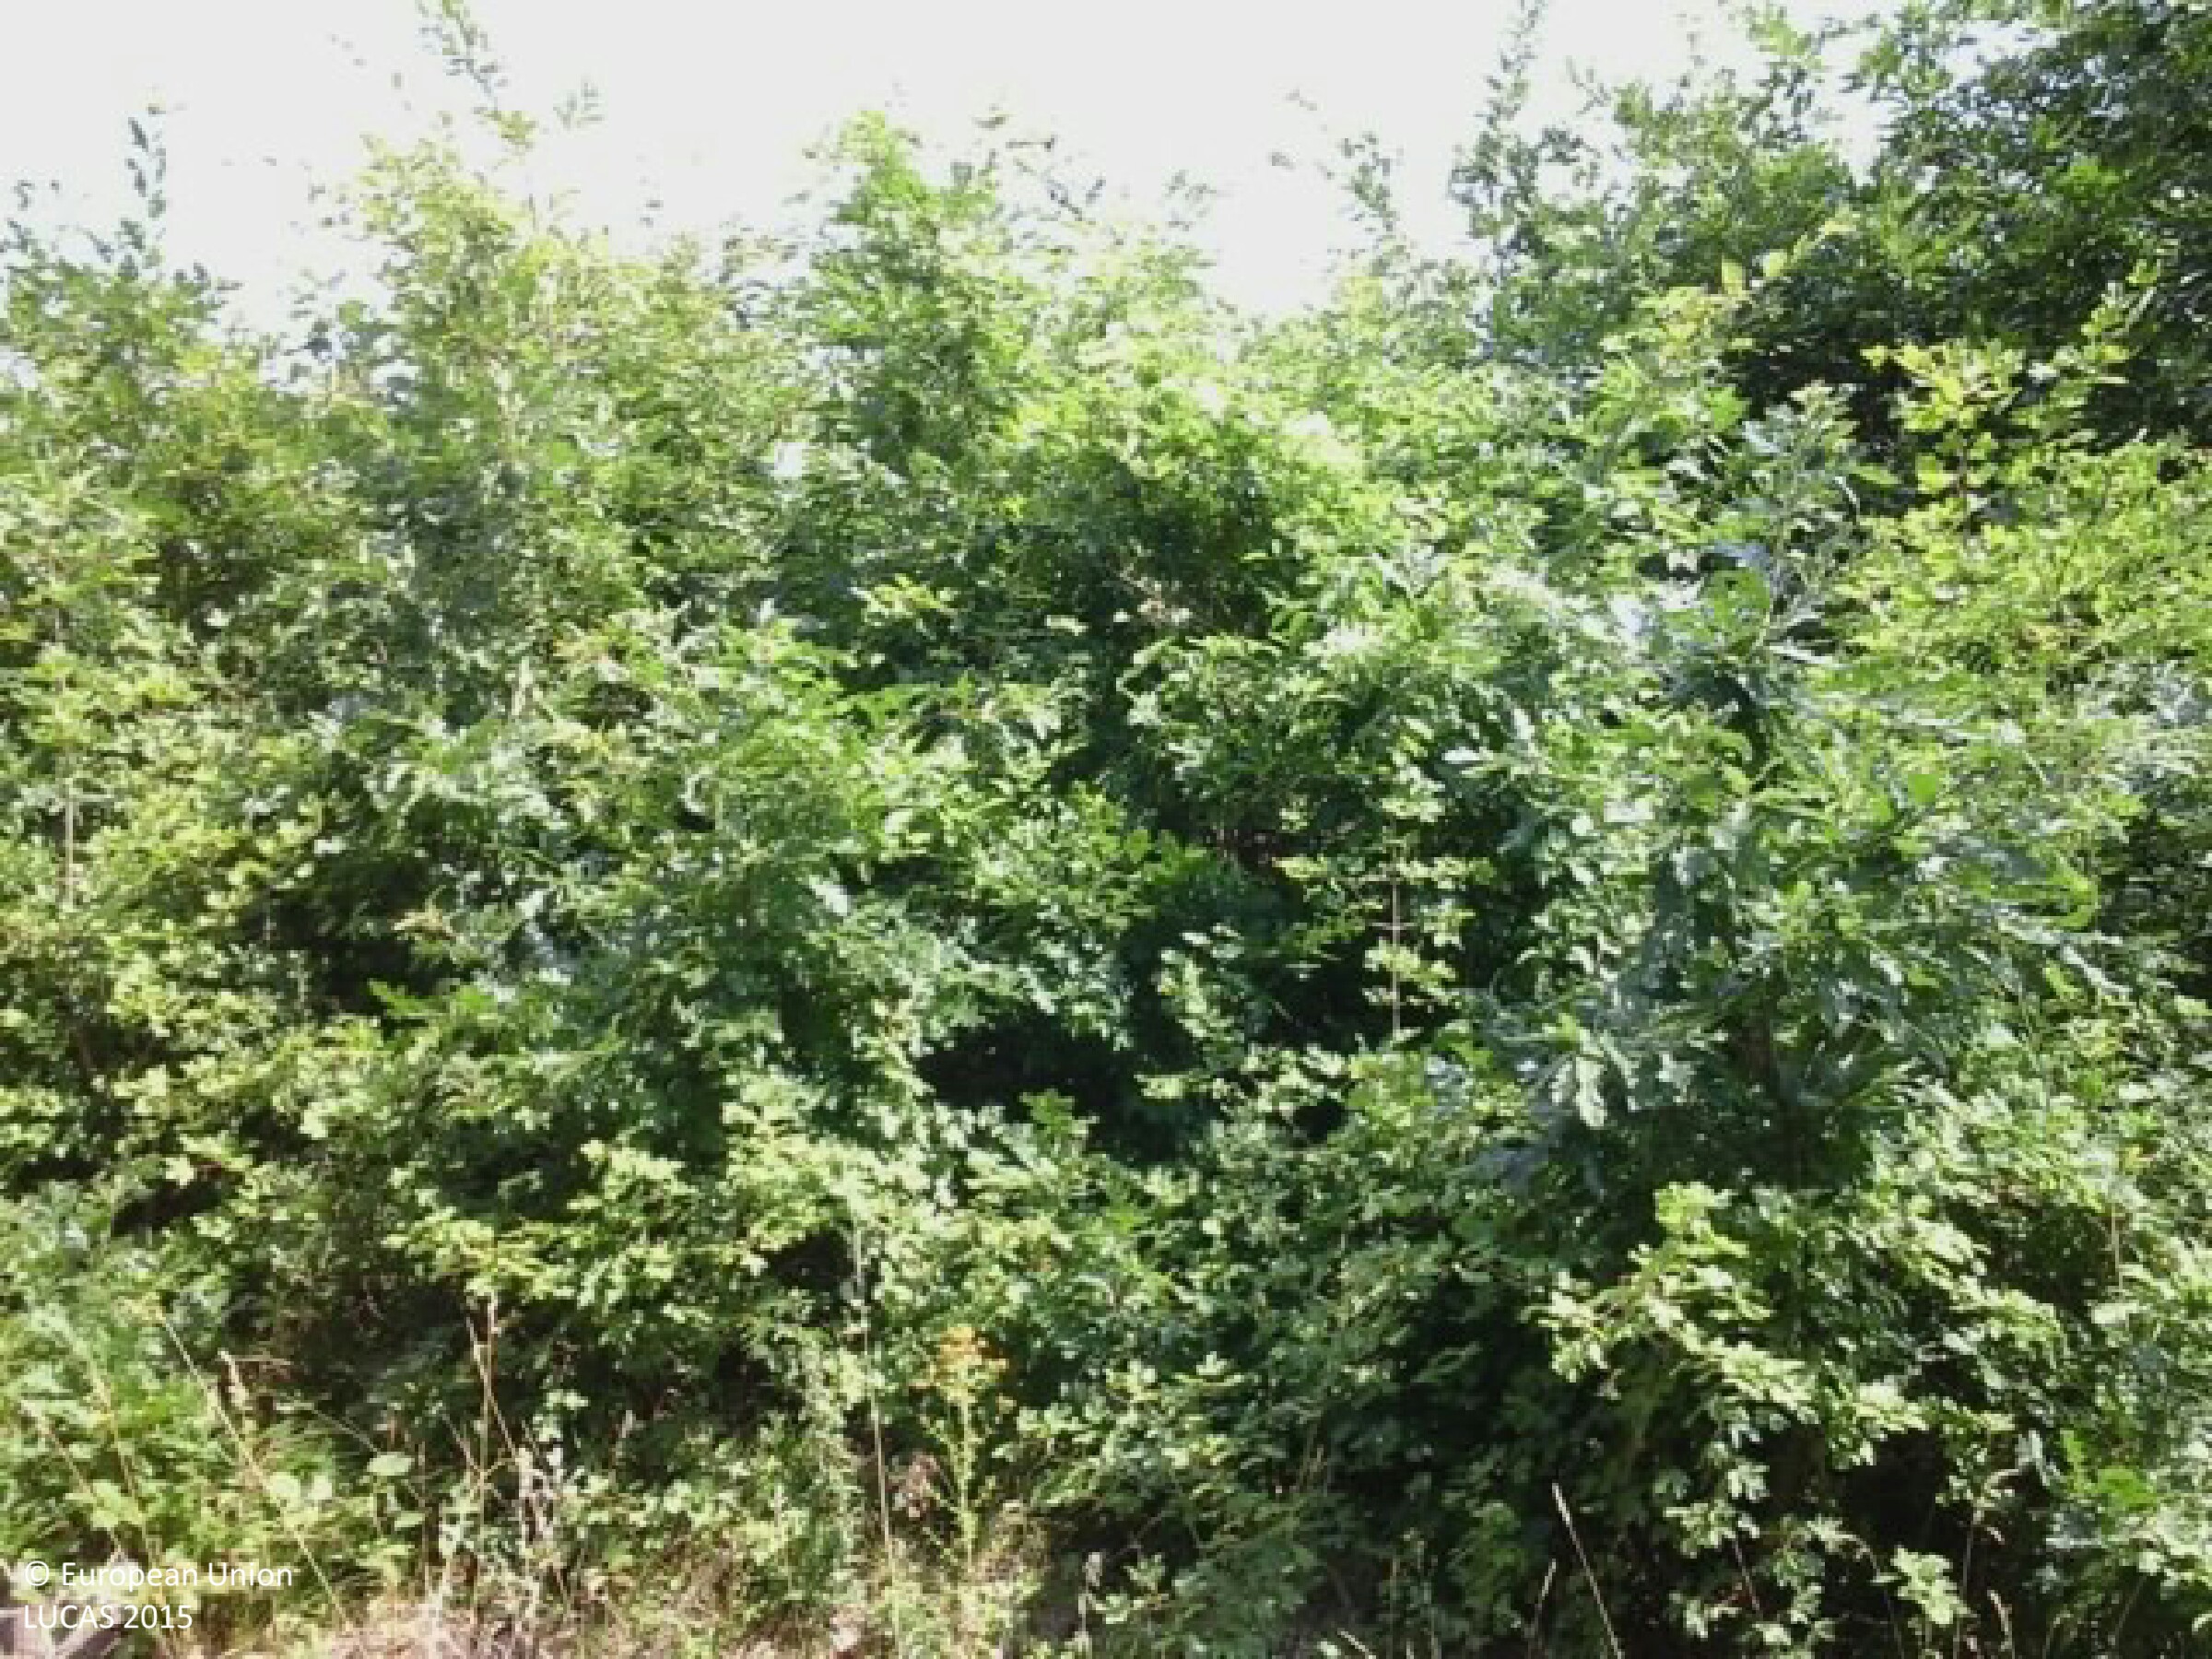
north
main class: Woodland
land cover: Broadleaved woodland
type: mesophytic deciduous forest
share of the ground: > 75 %
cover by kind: broadleaved forest trees 100 %
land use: Forestry
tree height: < 5 m
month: July
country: HU
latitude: 47.7355
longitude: 19.3420
